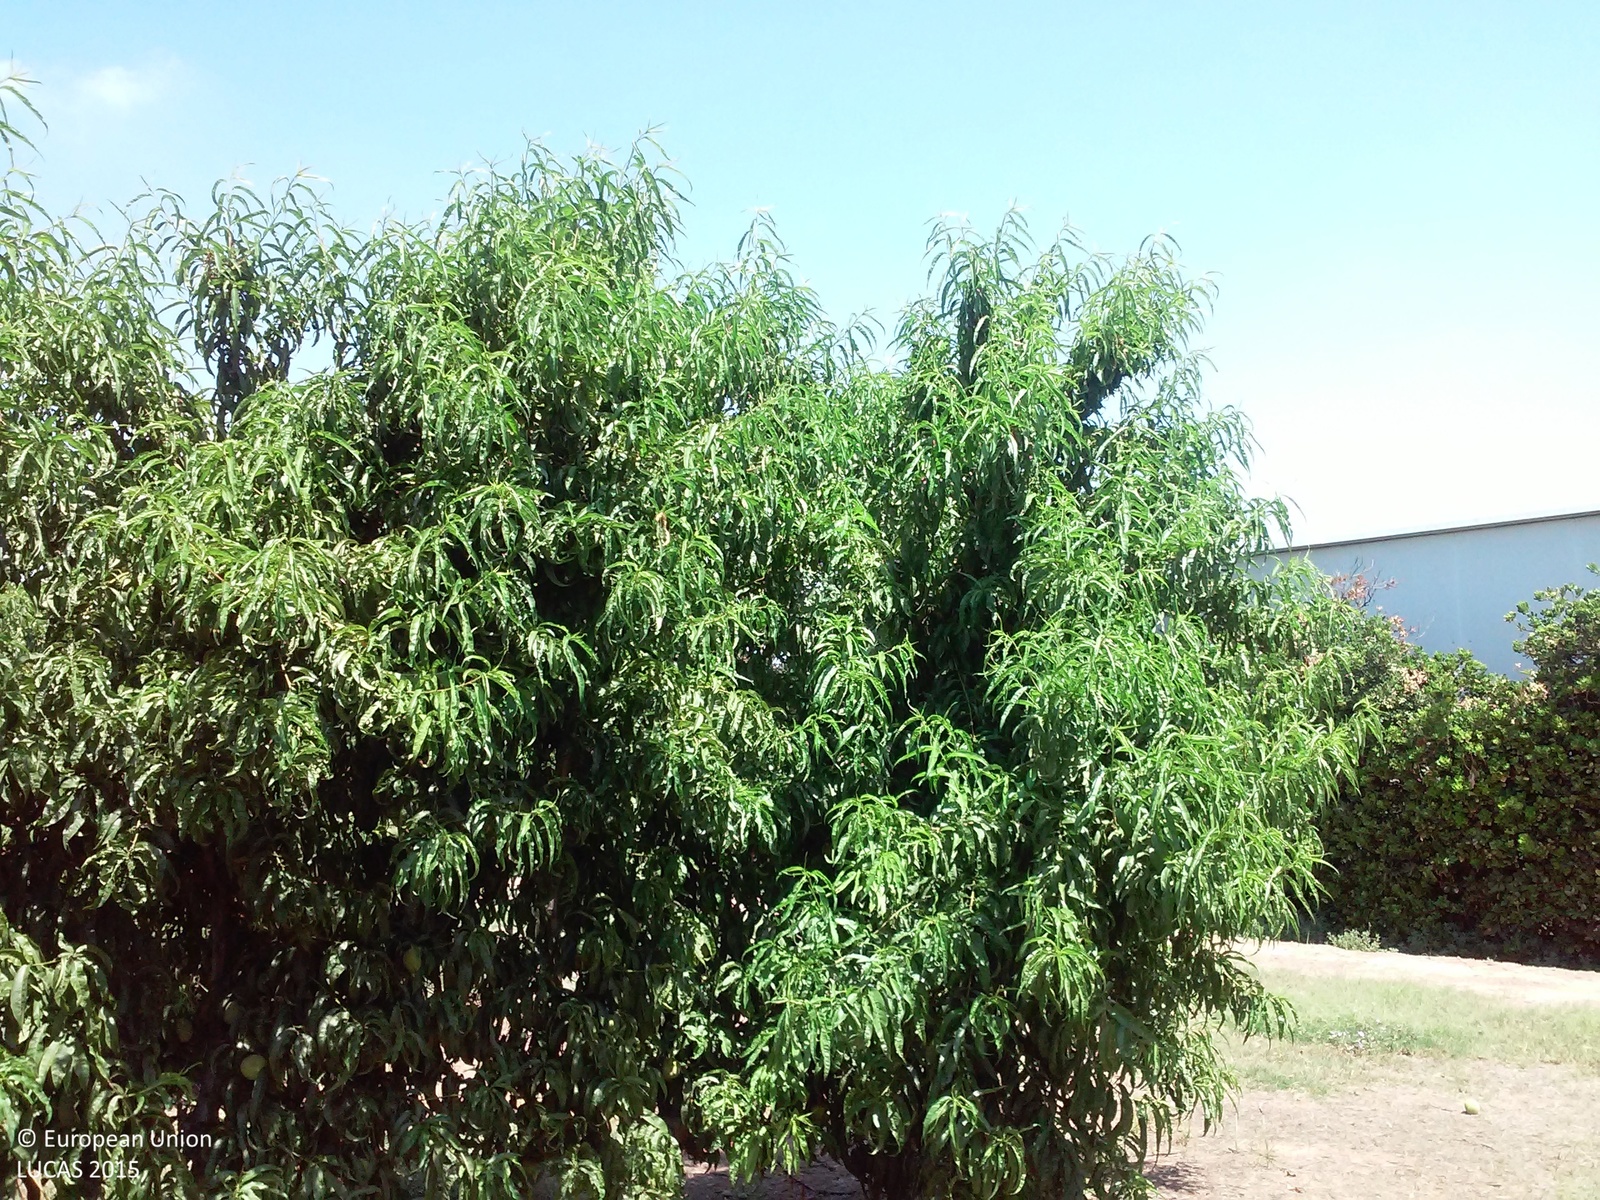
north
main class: Cropland
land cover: Other fruit trees and berries
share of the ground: 25 - 50 %
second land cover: Other bare soil
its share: > 75 %
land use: Agriculture (excluding fallow land and kitchen gardens)
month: July
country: ES
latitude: 41.6153
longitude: 0.5909
